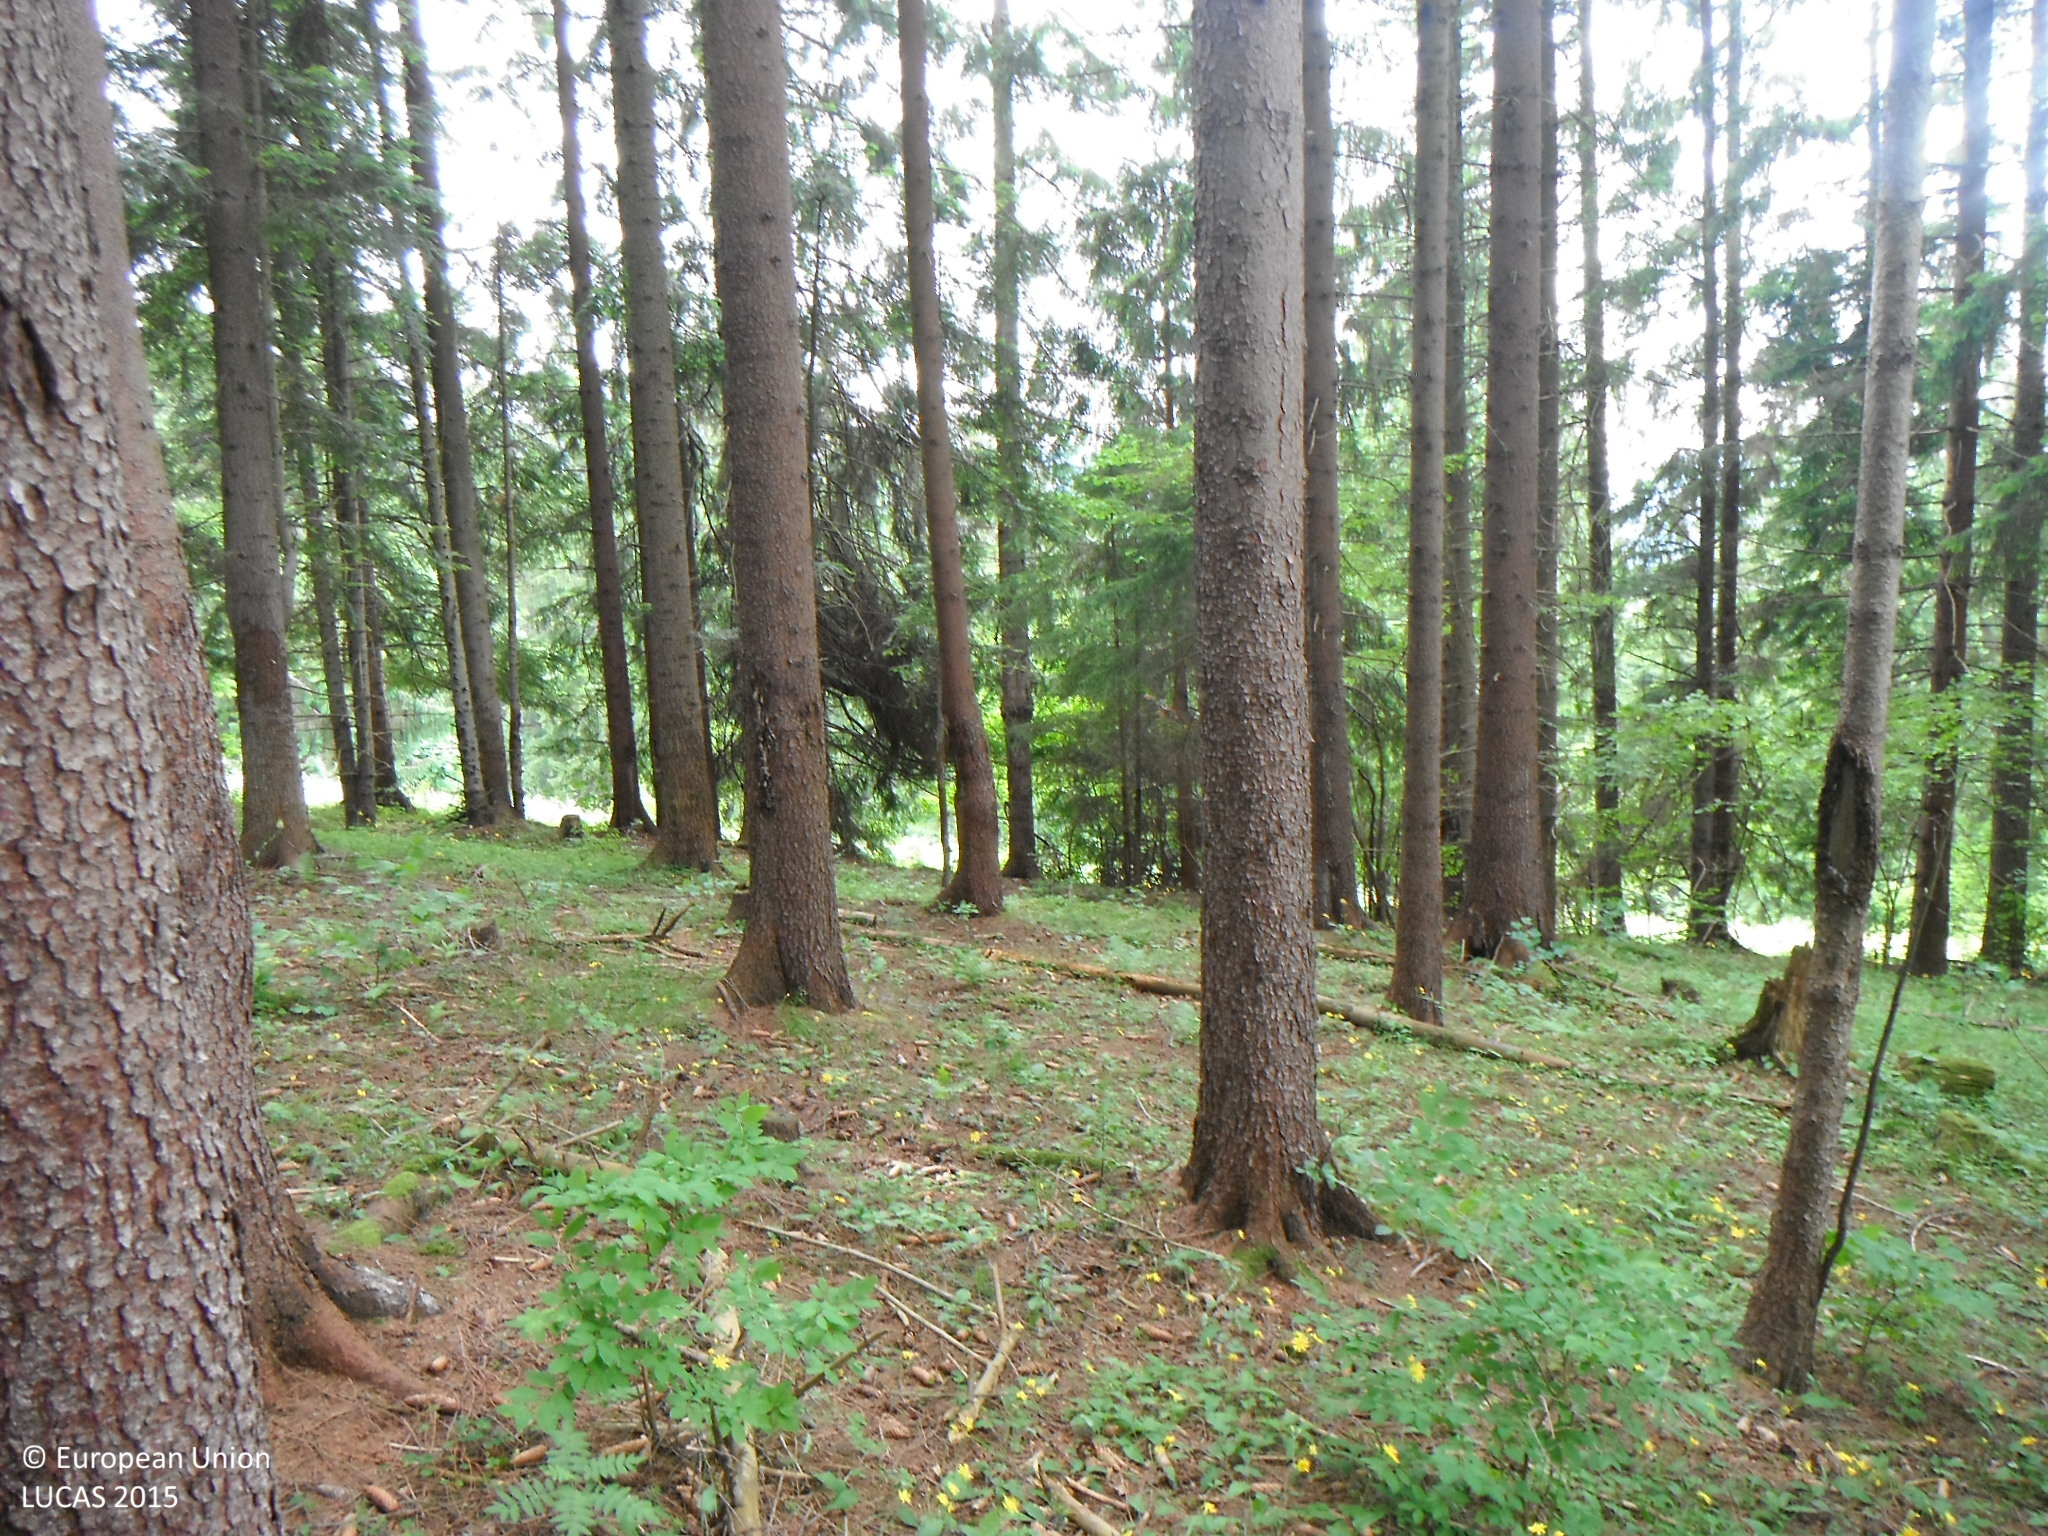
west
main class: Woodland
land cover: Spruce dominated coniferous woodland
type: alpine coniferous forest
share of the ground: > 75 %
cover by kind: coniferous forest trees 75 %, shrubs 10 %, herbaceous plants 10 %, lichens and mosses 5 %
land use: Forestry
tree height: > 5 m
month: June
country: SK
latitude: 49.0305
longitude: 19.4491
